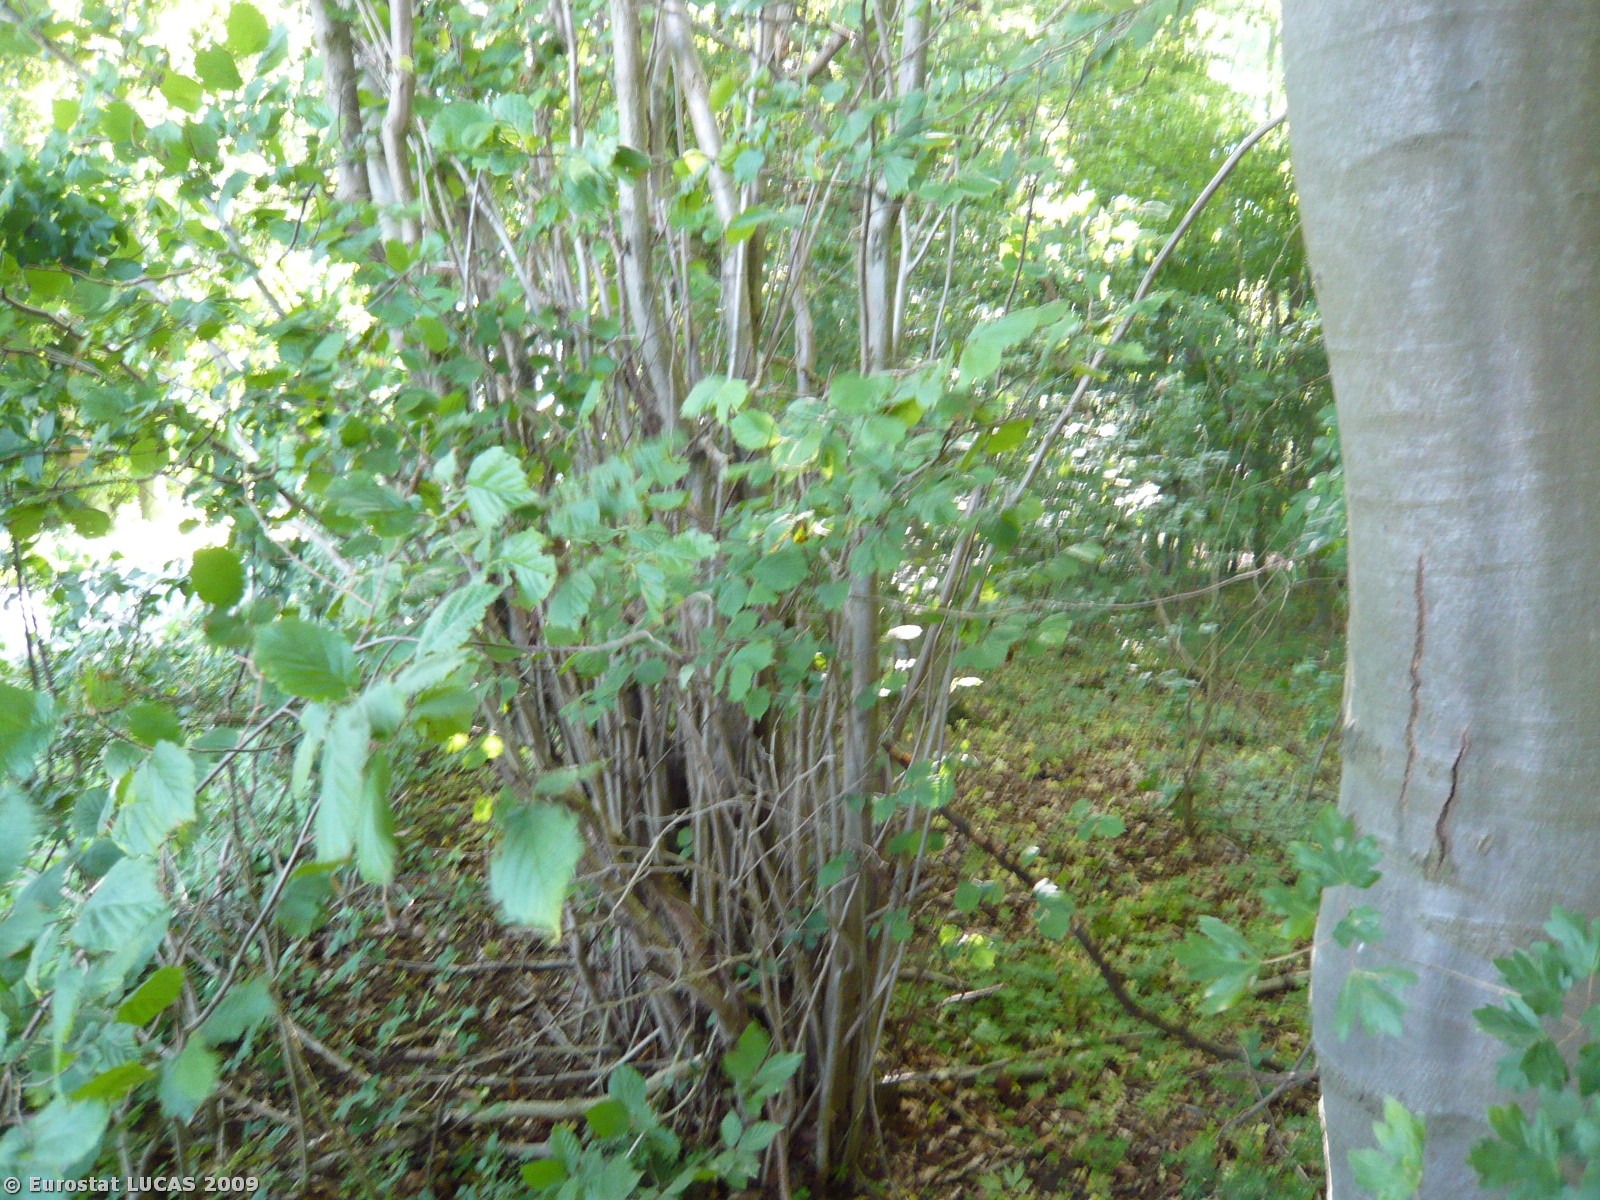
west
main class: Woodland
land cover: Broadleaved woodland
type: mesophytic deciduous forest
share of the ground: > 75 %
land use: Amenities, museums, leisure
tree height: > 5 m
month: June
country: DK
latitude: 54.8785
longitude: 11.9470
